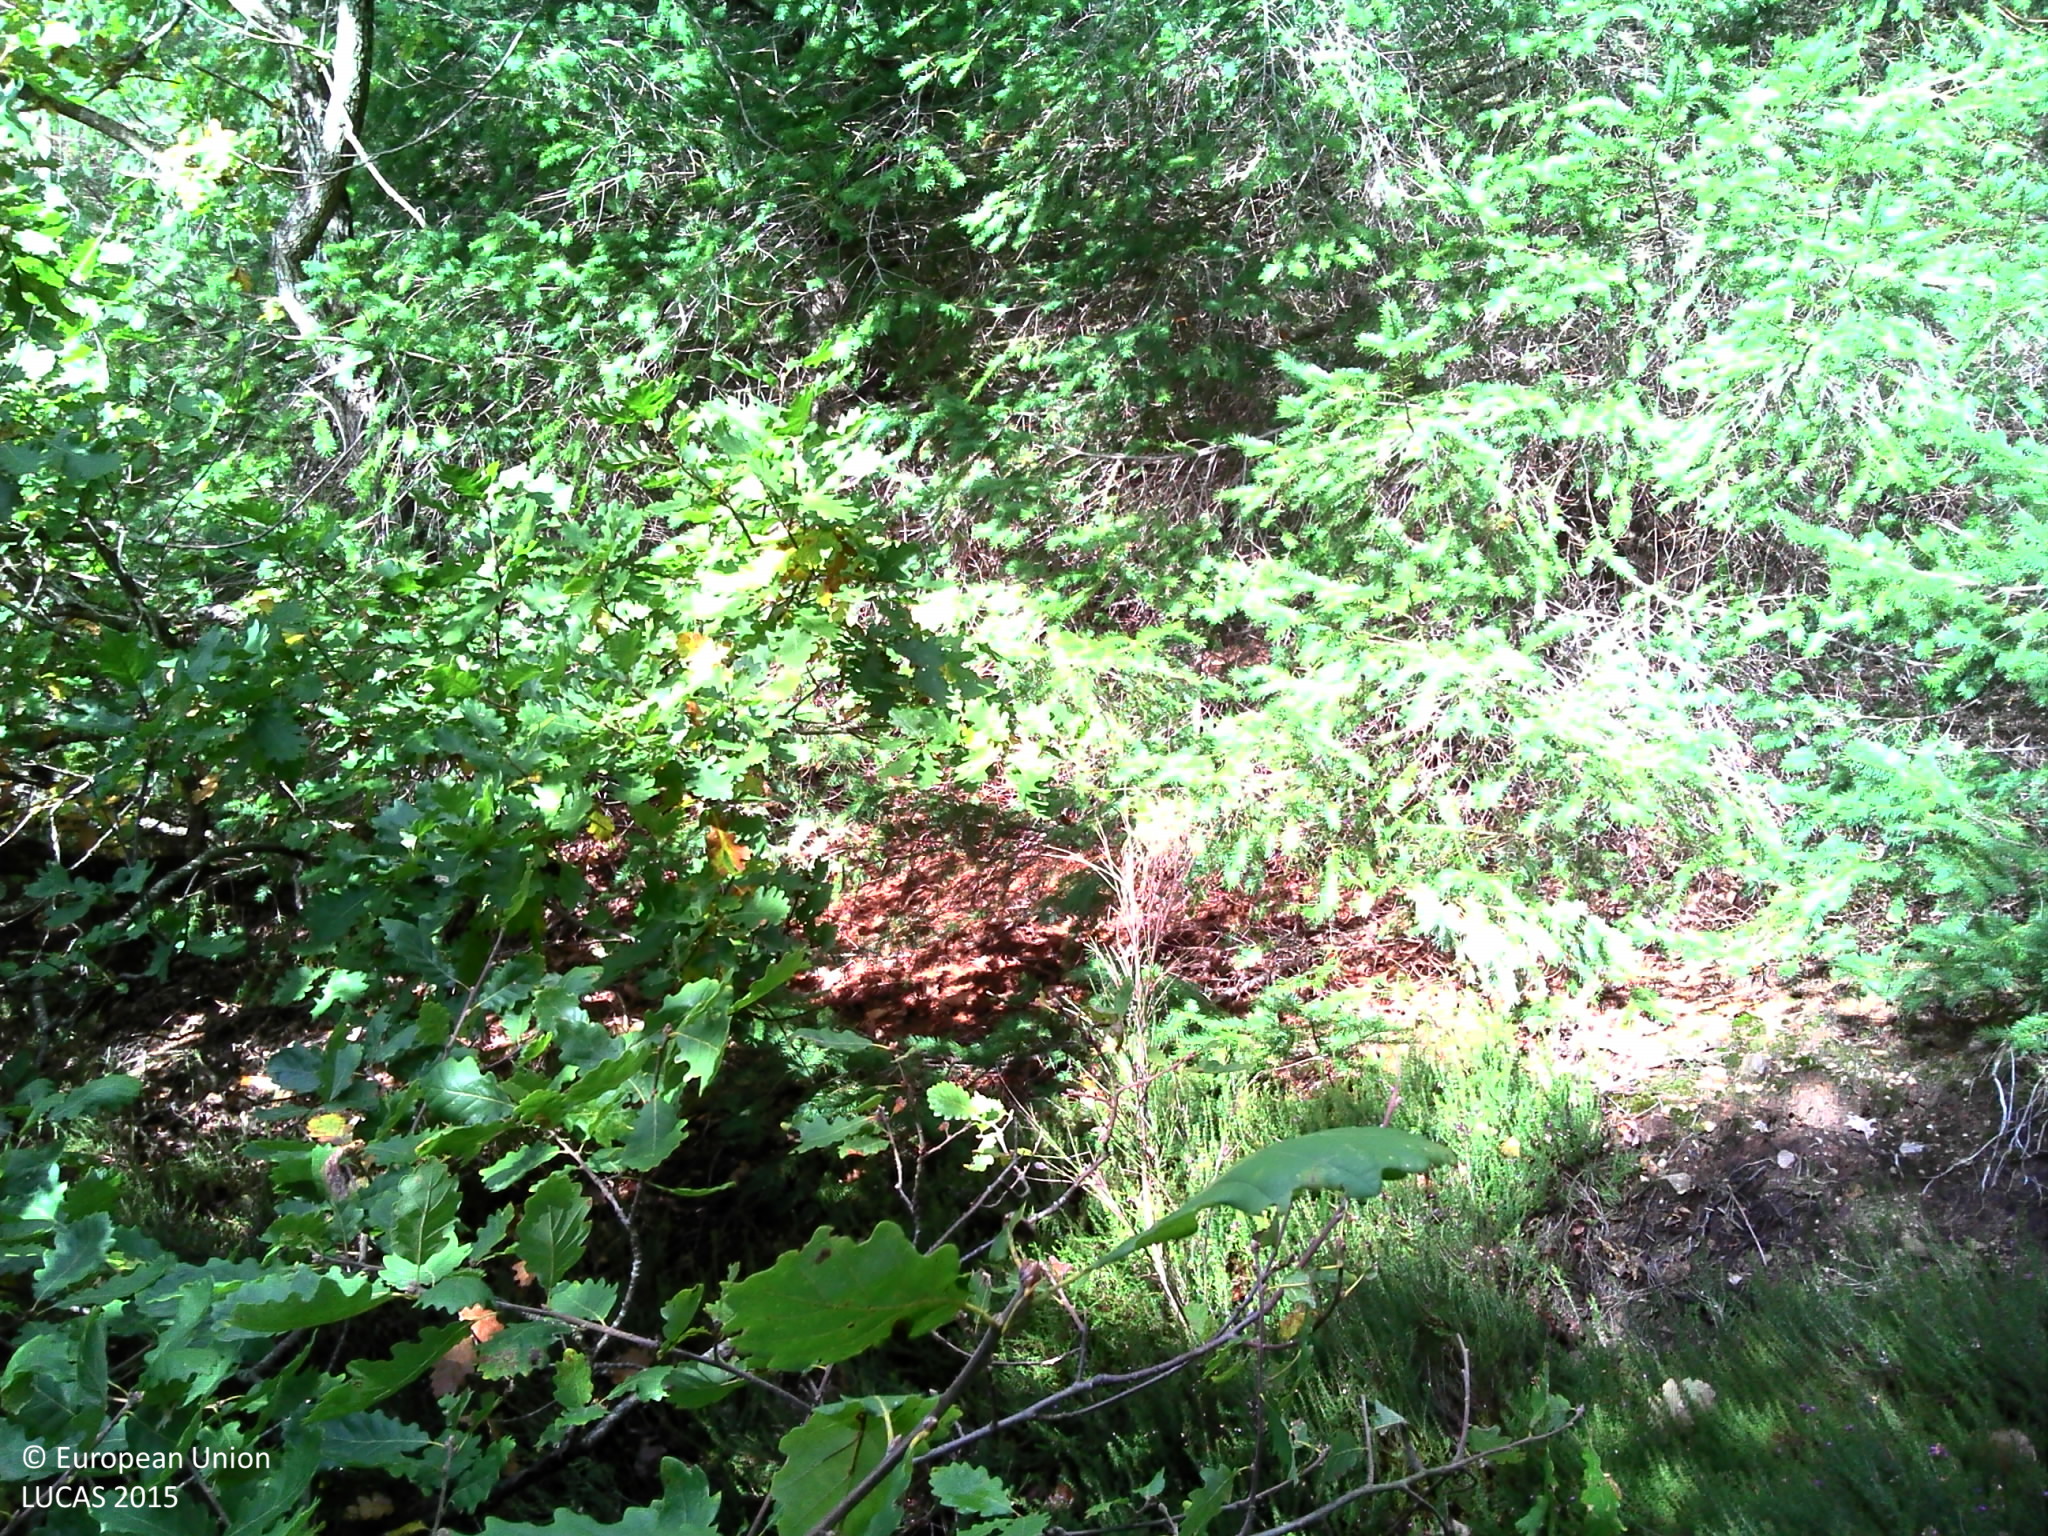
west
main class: Woodland
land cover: Spruce dominated mixed woodland
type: hemiboreal forest and nemoral coniferous forest and mixed broadleaved-coniferous forest
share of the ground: > 75 %
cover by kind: coniferous forest trees 50 %, broadleaved forest trees 30 %, shrubs 15 %, lichens and mosses 5 %
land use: Forestry
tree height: > 5 m
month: October
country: FR
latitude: 46.0891
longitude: 3.0535
